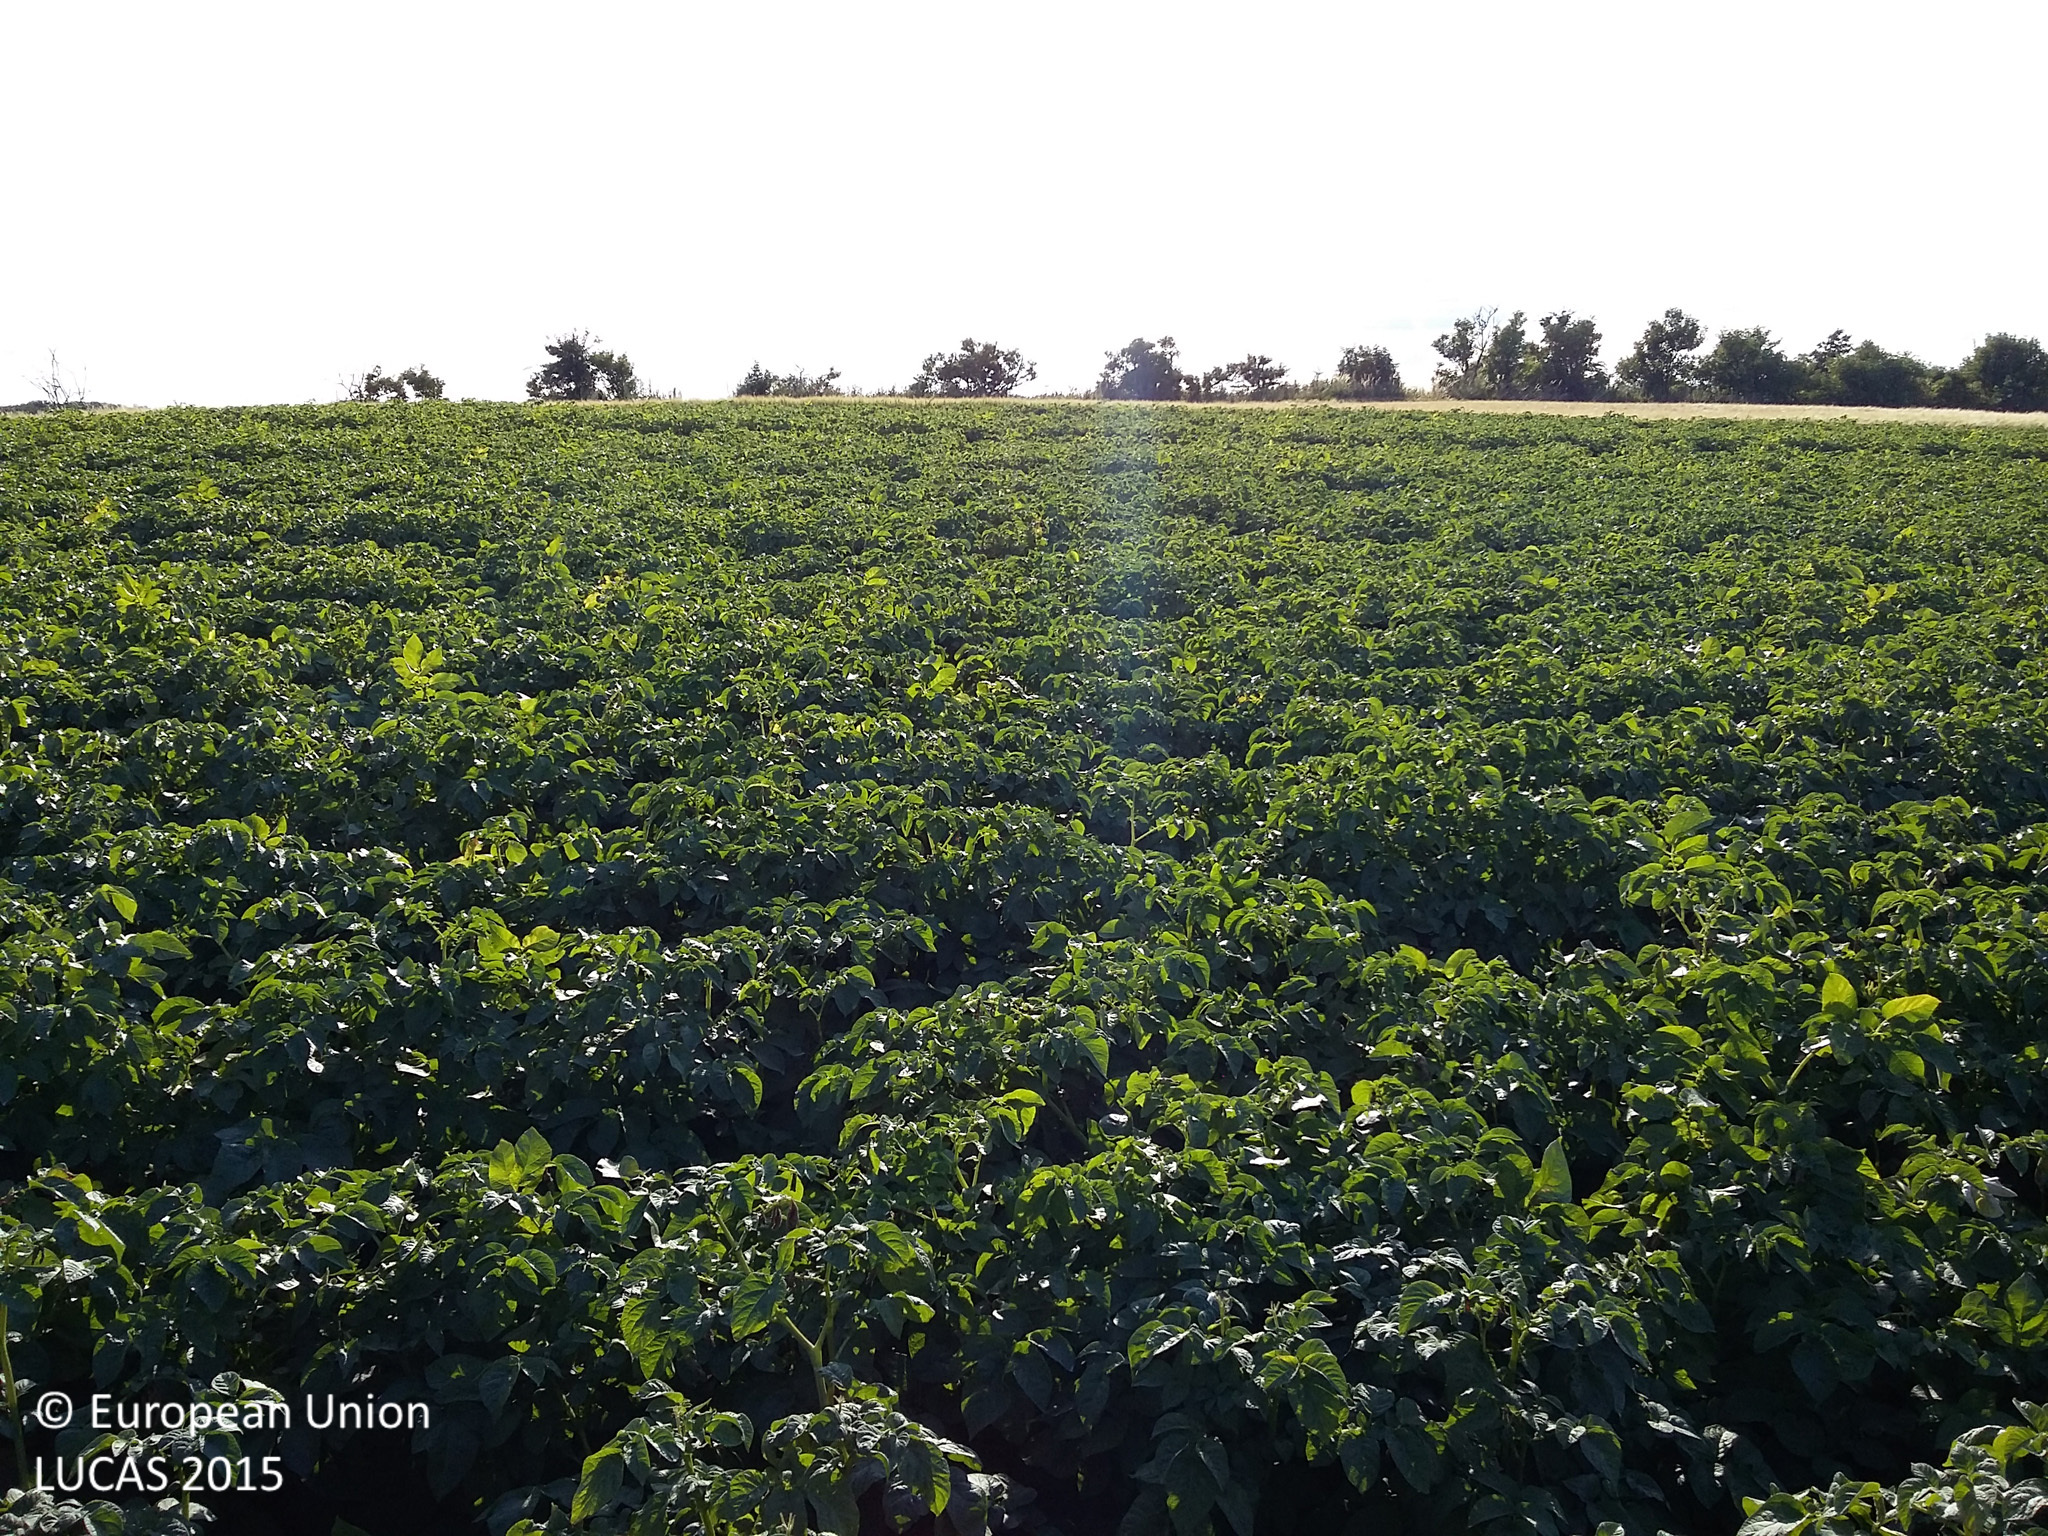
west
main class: Cropland
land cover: Potatoes
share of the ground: > 75 %
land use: Agriculture (excluding fallow land and kitchen gardens)
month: July
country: DK
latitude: 55.7668
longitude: 11.3853
